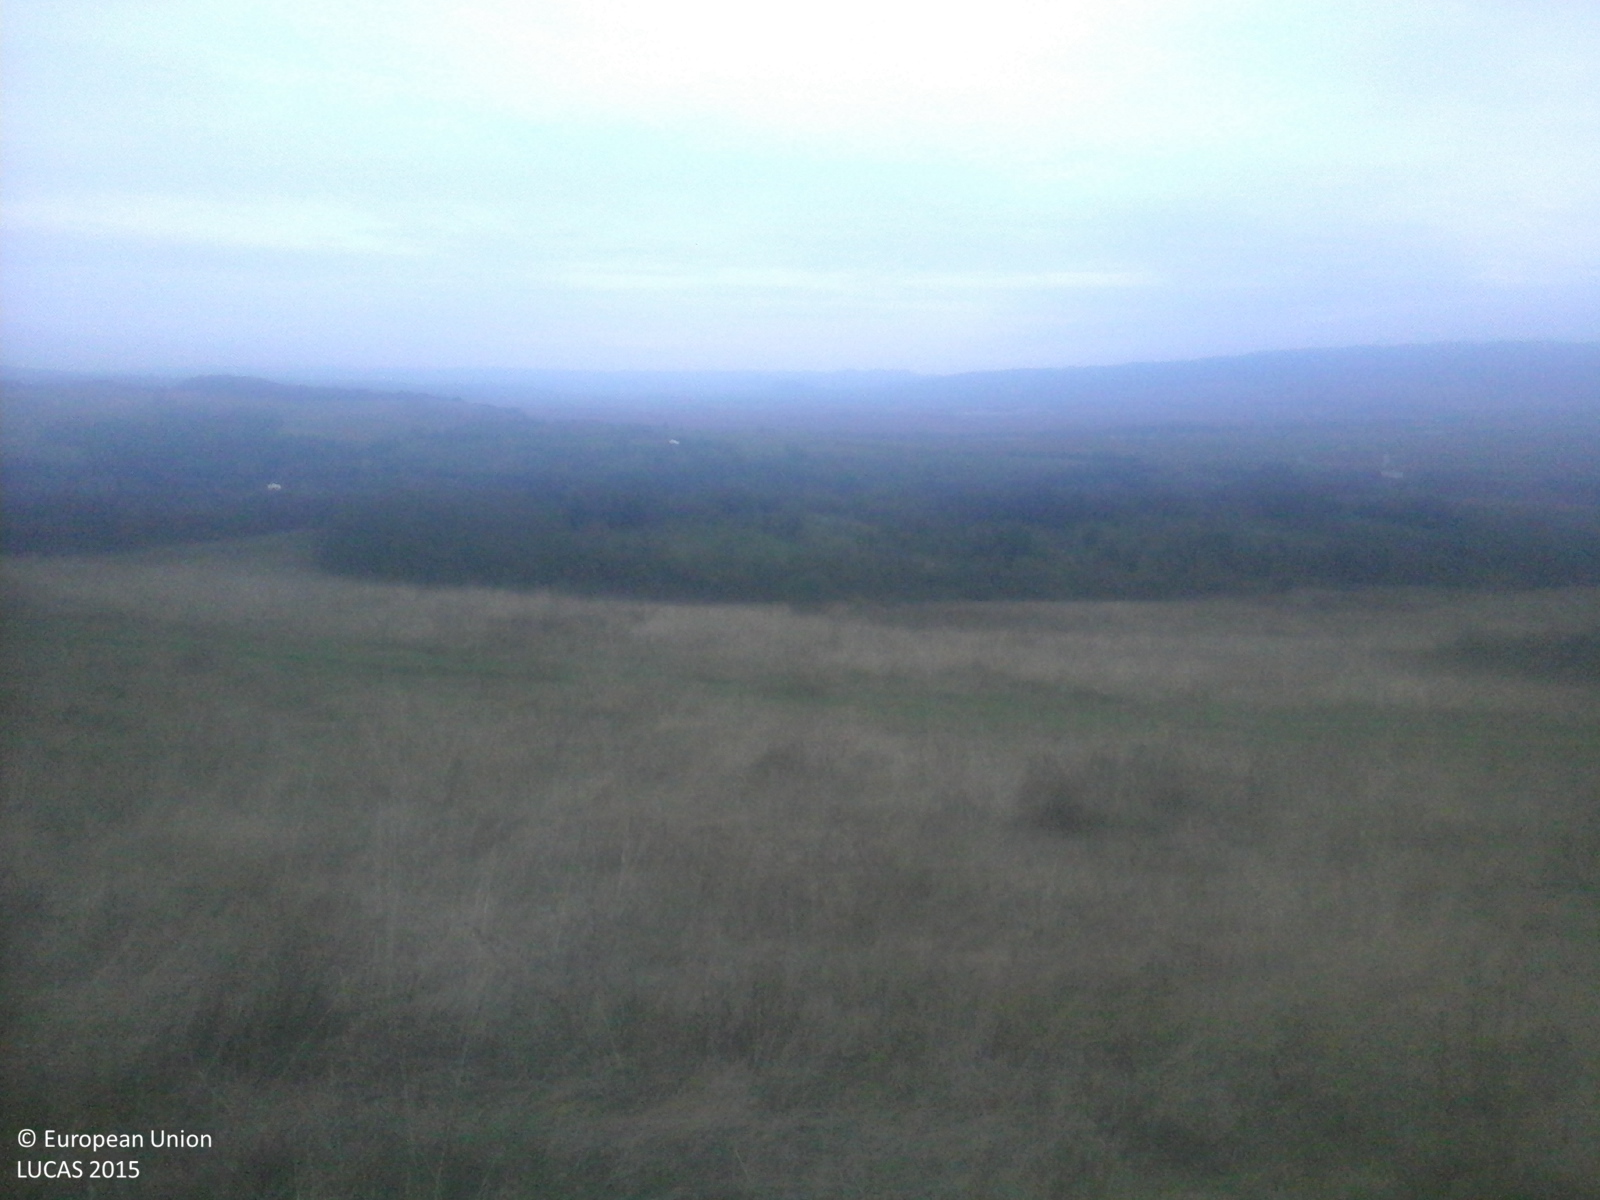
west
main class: Grassland
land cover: Grassland with sparse tree/shrub cover
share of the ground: > 75 %
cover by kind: herbaceous plants 85 %, shrubs 10 %, broadleaved forest trees 5 %
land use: Agriculture (excluding fallow land and kitchen gardens)
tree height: < 5 m
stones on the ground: < 10 %
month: September
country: RO
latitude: 45.8611
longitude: 23.3142
